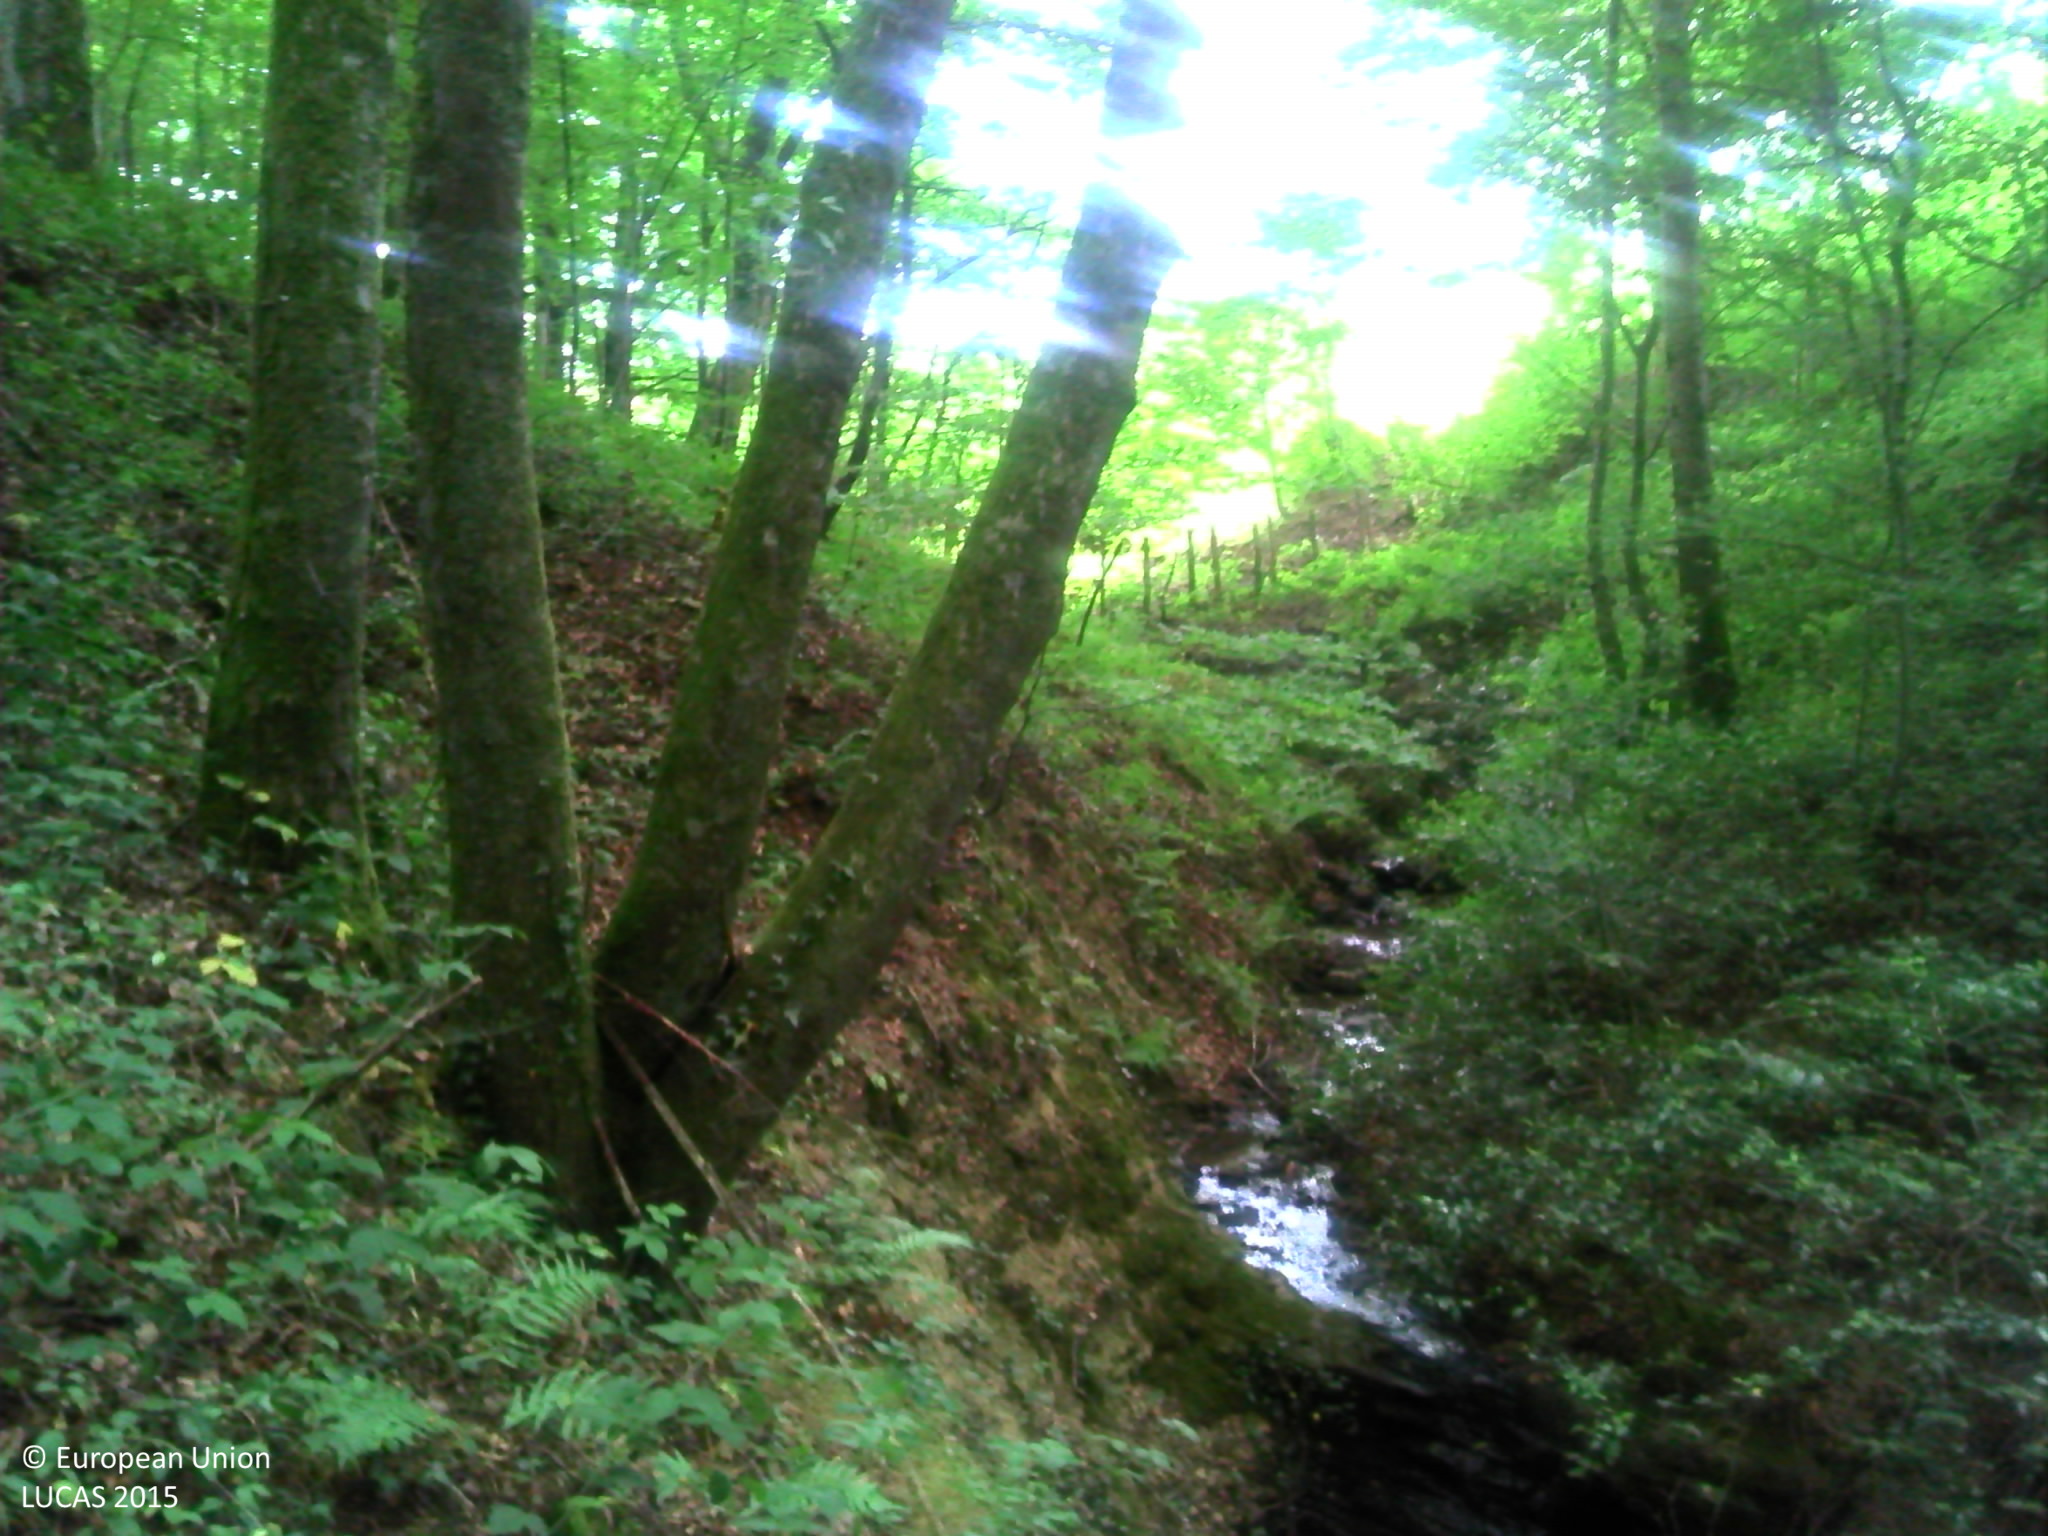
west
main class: Woodland
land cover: Broadleaved woodland
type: mesophytic deciduous forest
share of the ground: > 75 %
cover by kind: broadleaved forest trees 85 %, herbaceous plants 10 %, shrubs 5 %
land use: Forestry
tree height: > 5 m
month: July
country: FR
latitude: 46.3730
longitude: 1.7104
